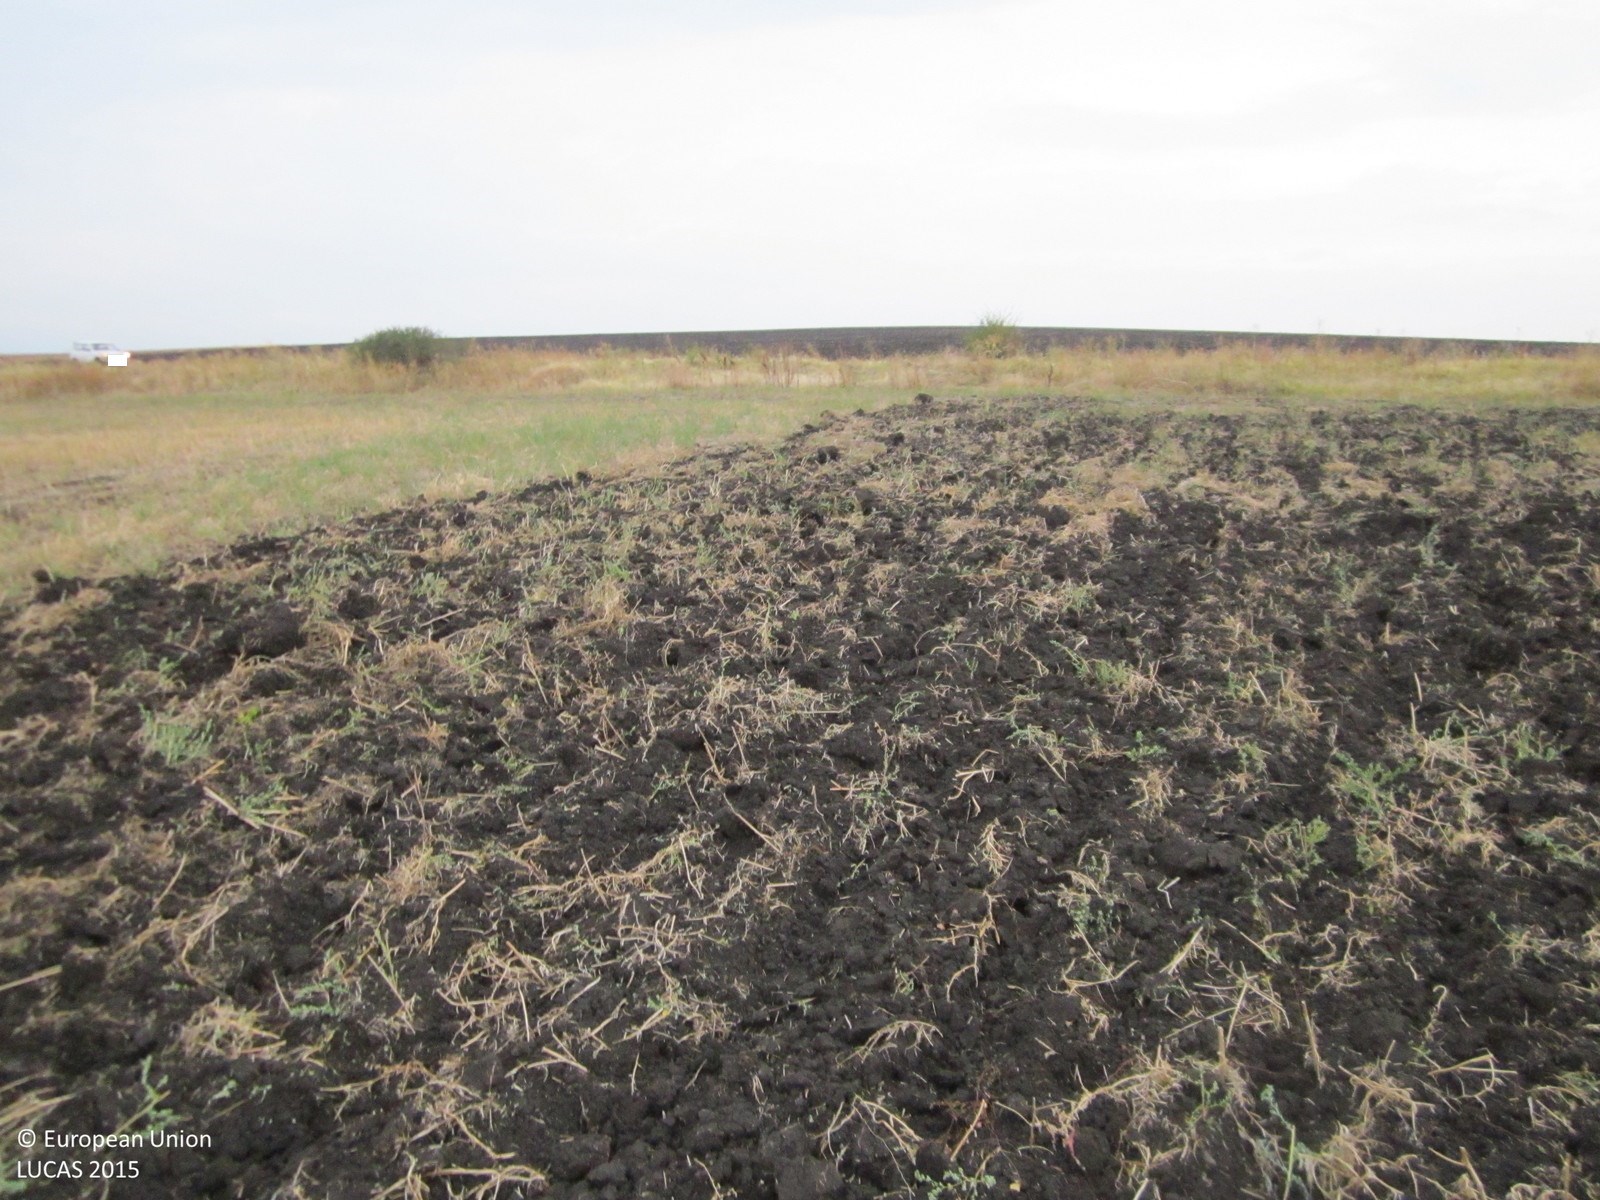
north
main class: Cropland
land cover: Rape and turnip rape
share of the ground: 10 - 25 %
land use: Agriculture (excluding fallow land and kitchen gardens)
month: August
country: BG
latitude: 42.5102
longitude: 27.0099
